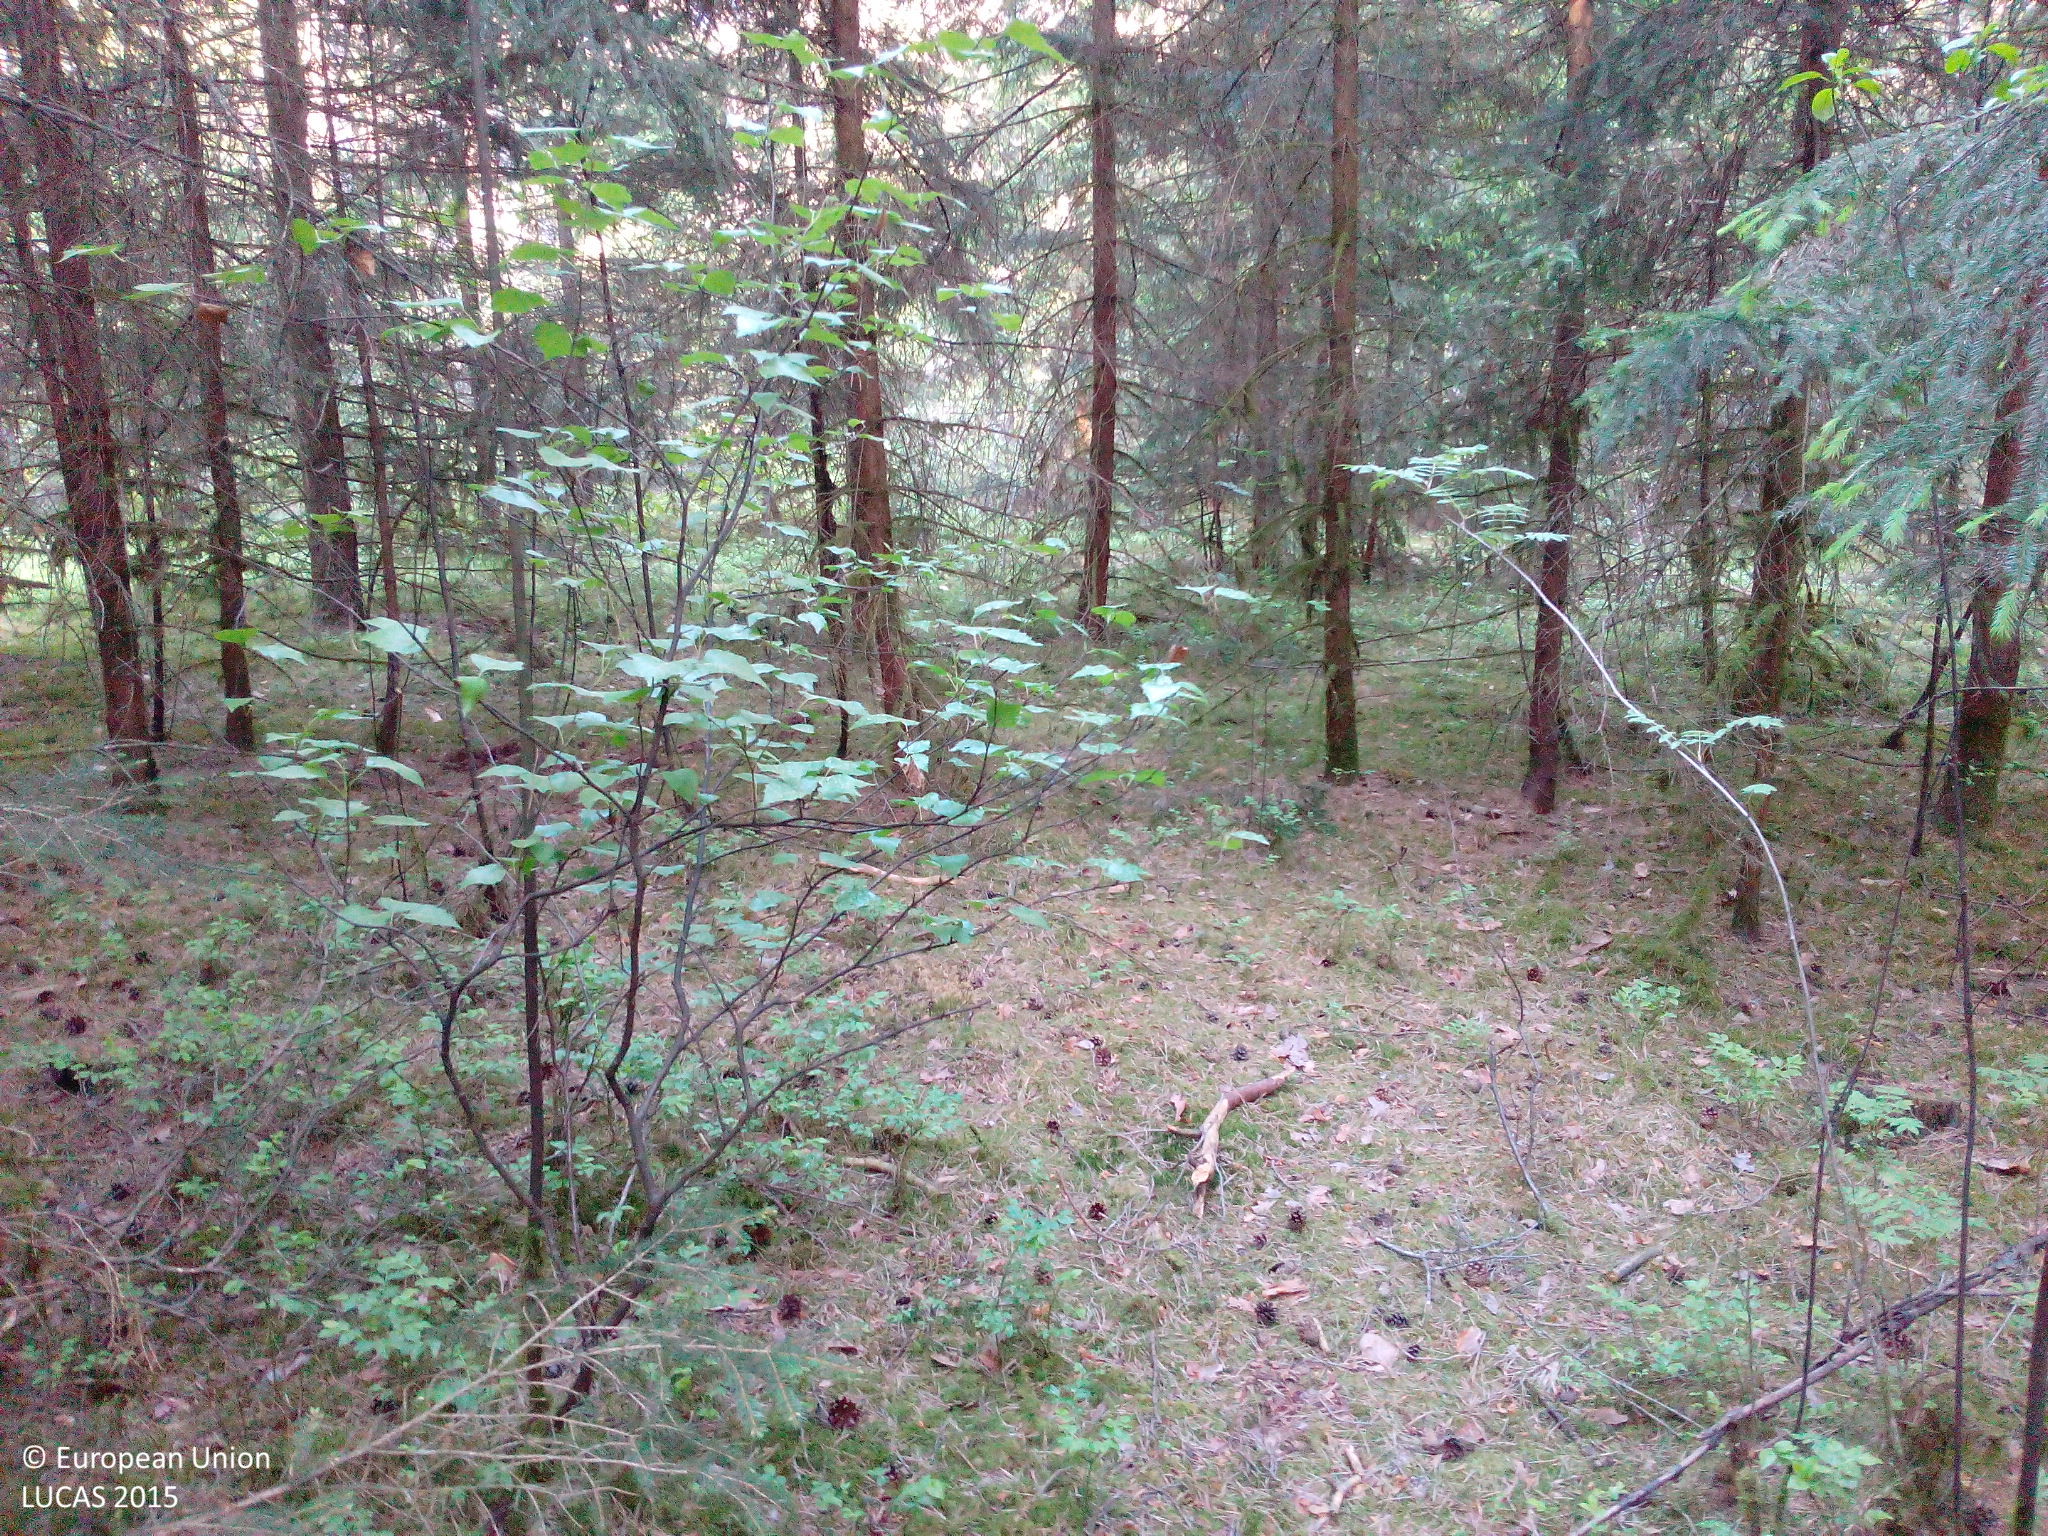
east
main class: Woodland
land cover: Other coniferous woodland
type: hemiboreal forest and nemoral coniferous forest and mixed broadleaved-coniferous forest
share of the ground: > 75 %
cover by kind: coniferous forest trees 80 %, unconsolidated bare surface 10 %, herbaceous plants 5 %, lichens and mosses 5 %
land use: Forestry
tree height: > 5 m
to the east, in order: Other coniferous woodland; Tracks; Pine dominated coniferous woodland; Tracks; Pine dominated coniferous woodland; Other coniferous woodland; Other mixed woodland; Fences; Other mixed woodland
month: May
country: DE
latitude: 49.1858
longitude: 11.4401
